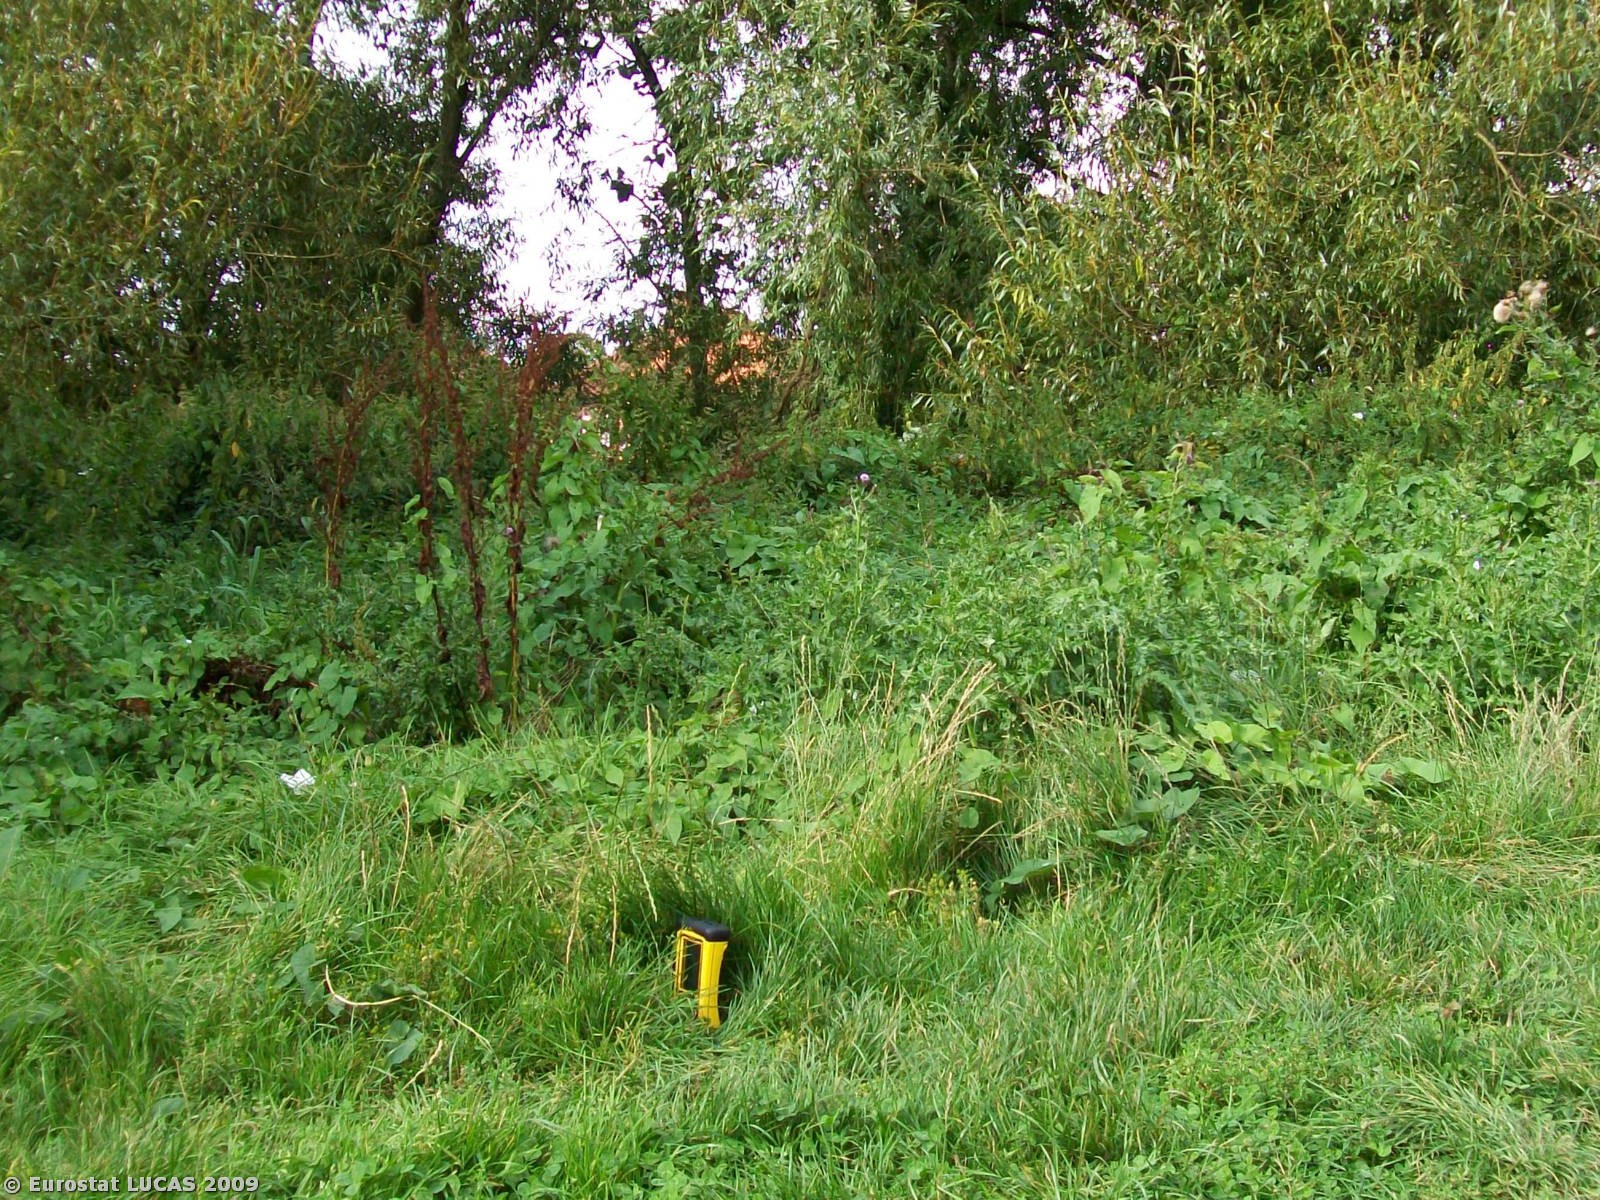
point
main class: Grassland
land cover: Grassland with sparse tree/shrub cover
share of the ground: > 75 %
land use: Fallow land
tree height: > 5 m
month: August
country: GB
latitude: 53.9821
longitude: -1.0687
